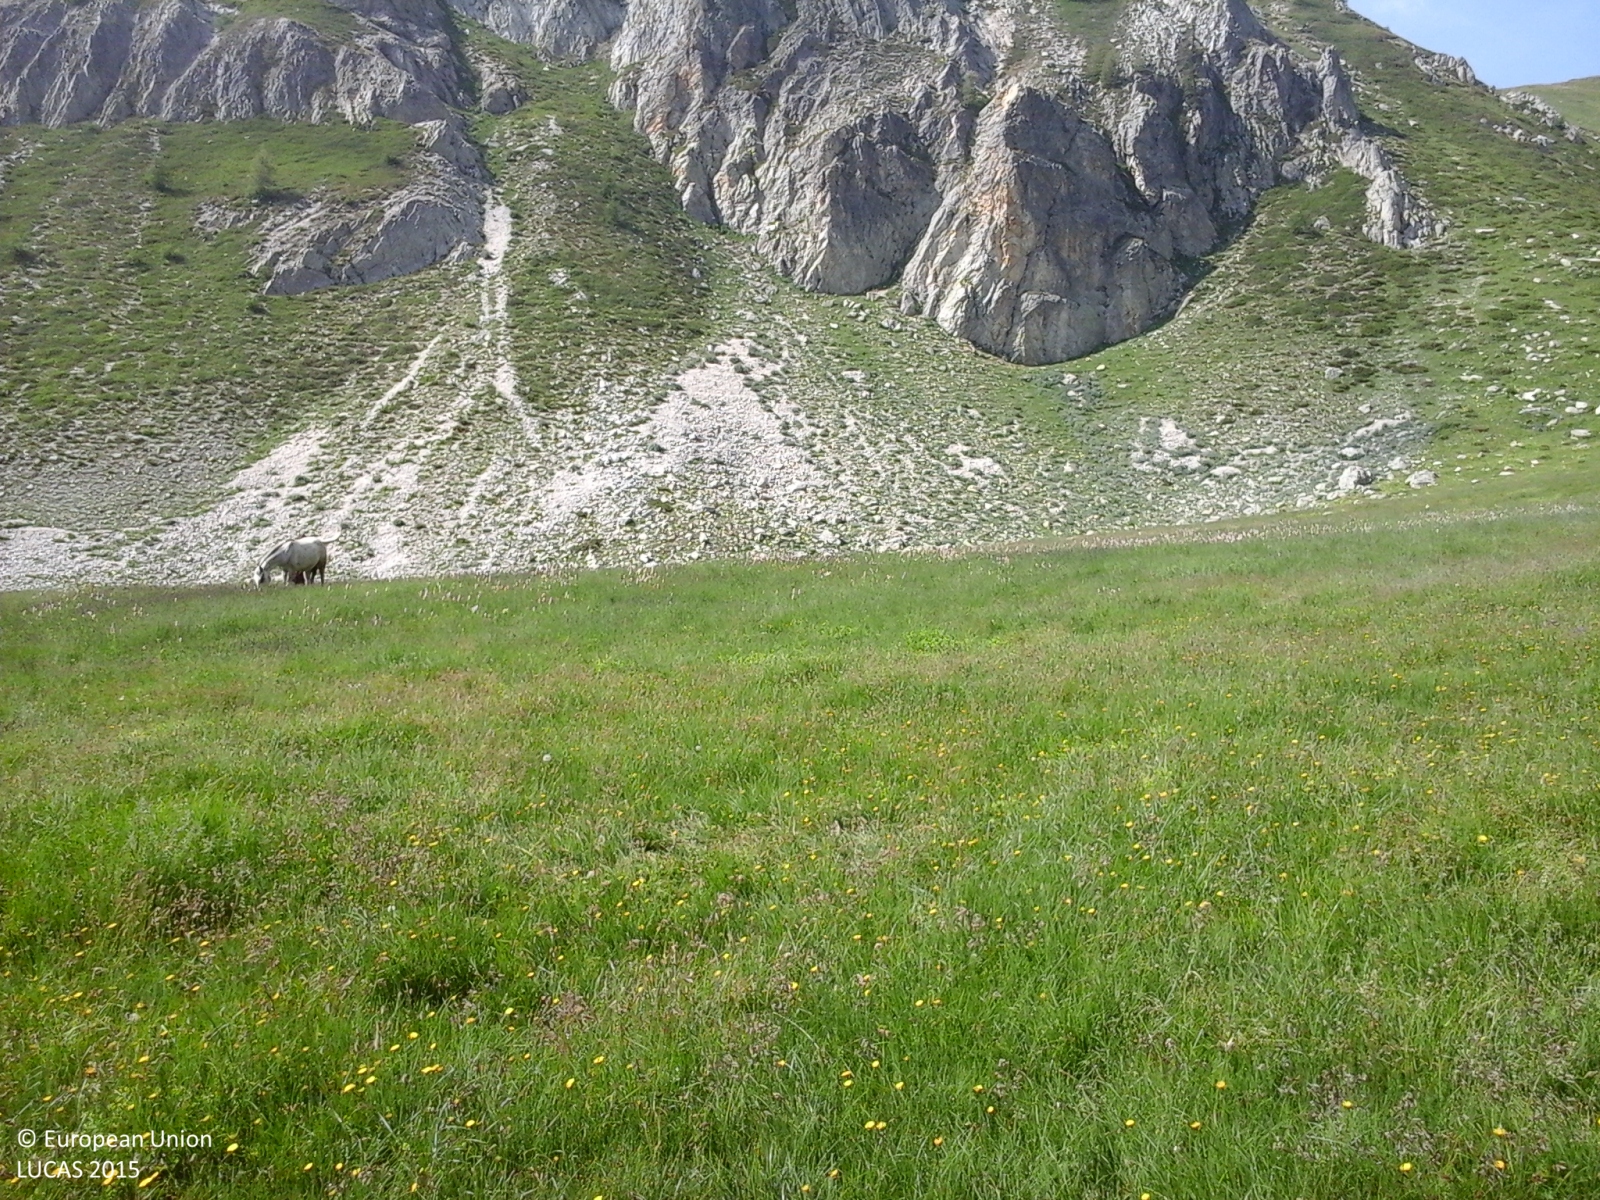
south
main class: Grassland
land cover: Grassland without tree/shrub cover
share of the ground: > 75 %
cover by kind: herbaceous plants 100 %
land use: Agriculture (excluding fallow land and kitchen gardens)
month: July
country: IT
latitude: 44.4011
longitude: 7.1305
